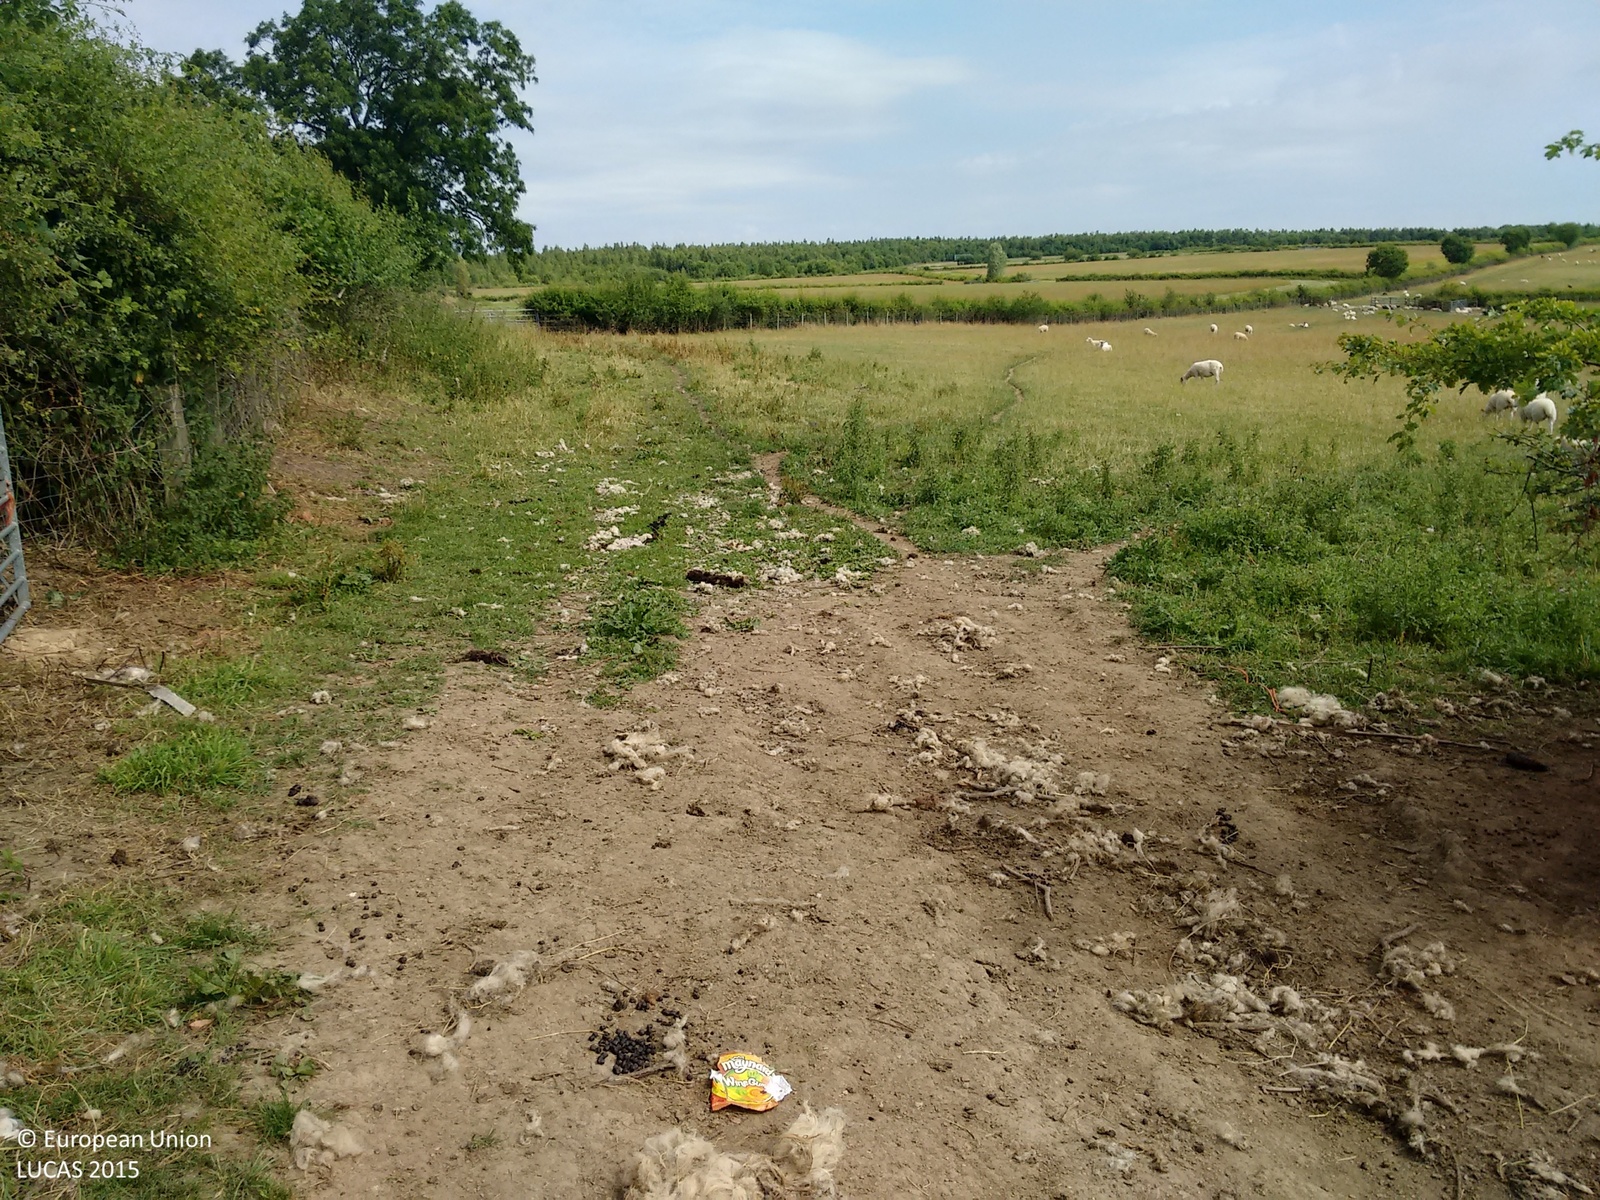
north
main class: Grassland
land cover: Grassland without tree/shrub cover
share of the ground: > 75 %
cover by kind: herbaceous plants 100 %
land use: Agriculture (excluding fallow land and kitchen gardens)
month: July
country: GB
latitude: 53.0227
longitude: -1.4246
